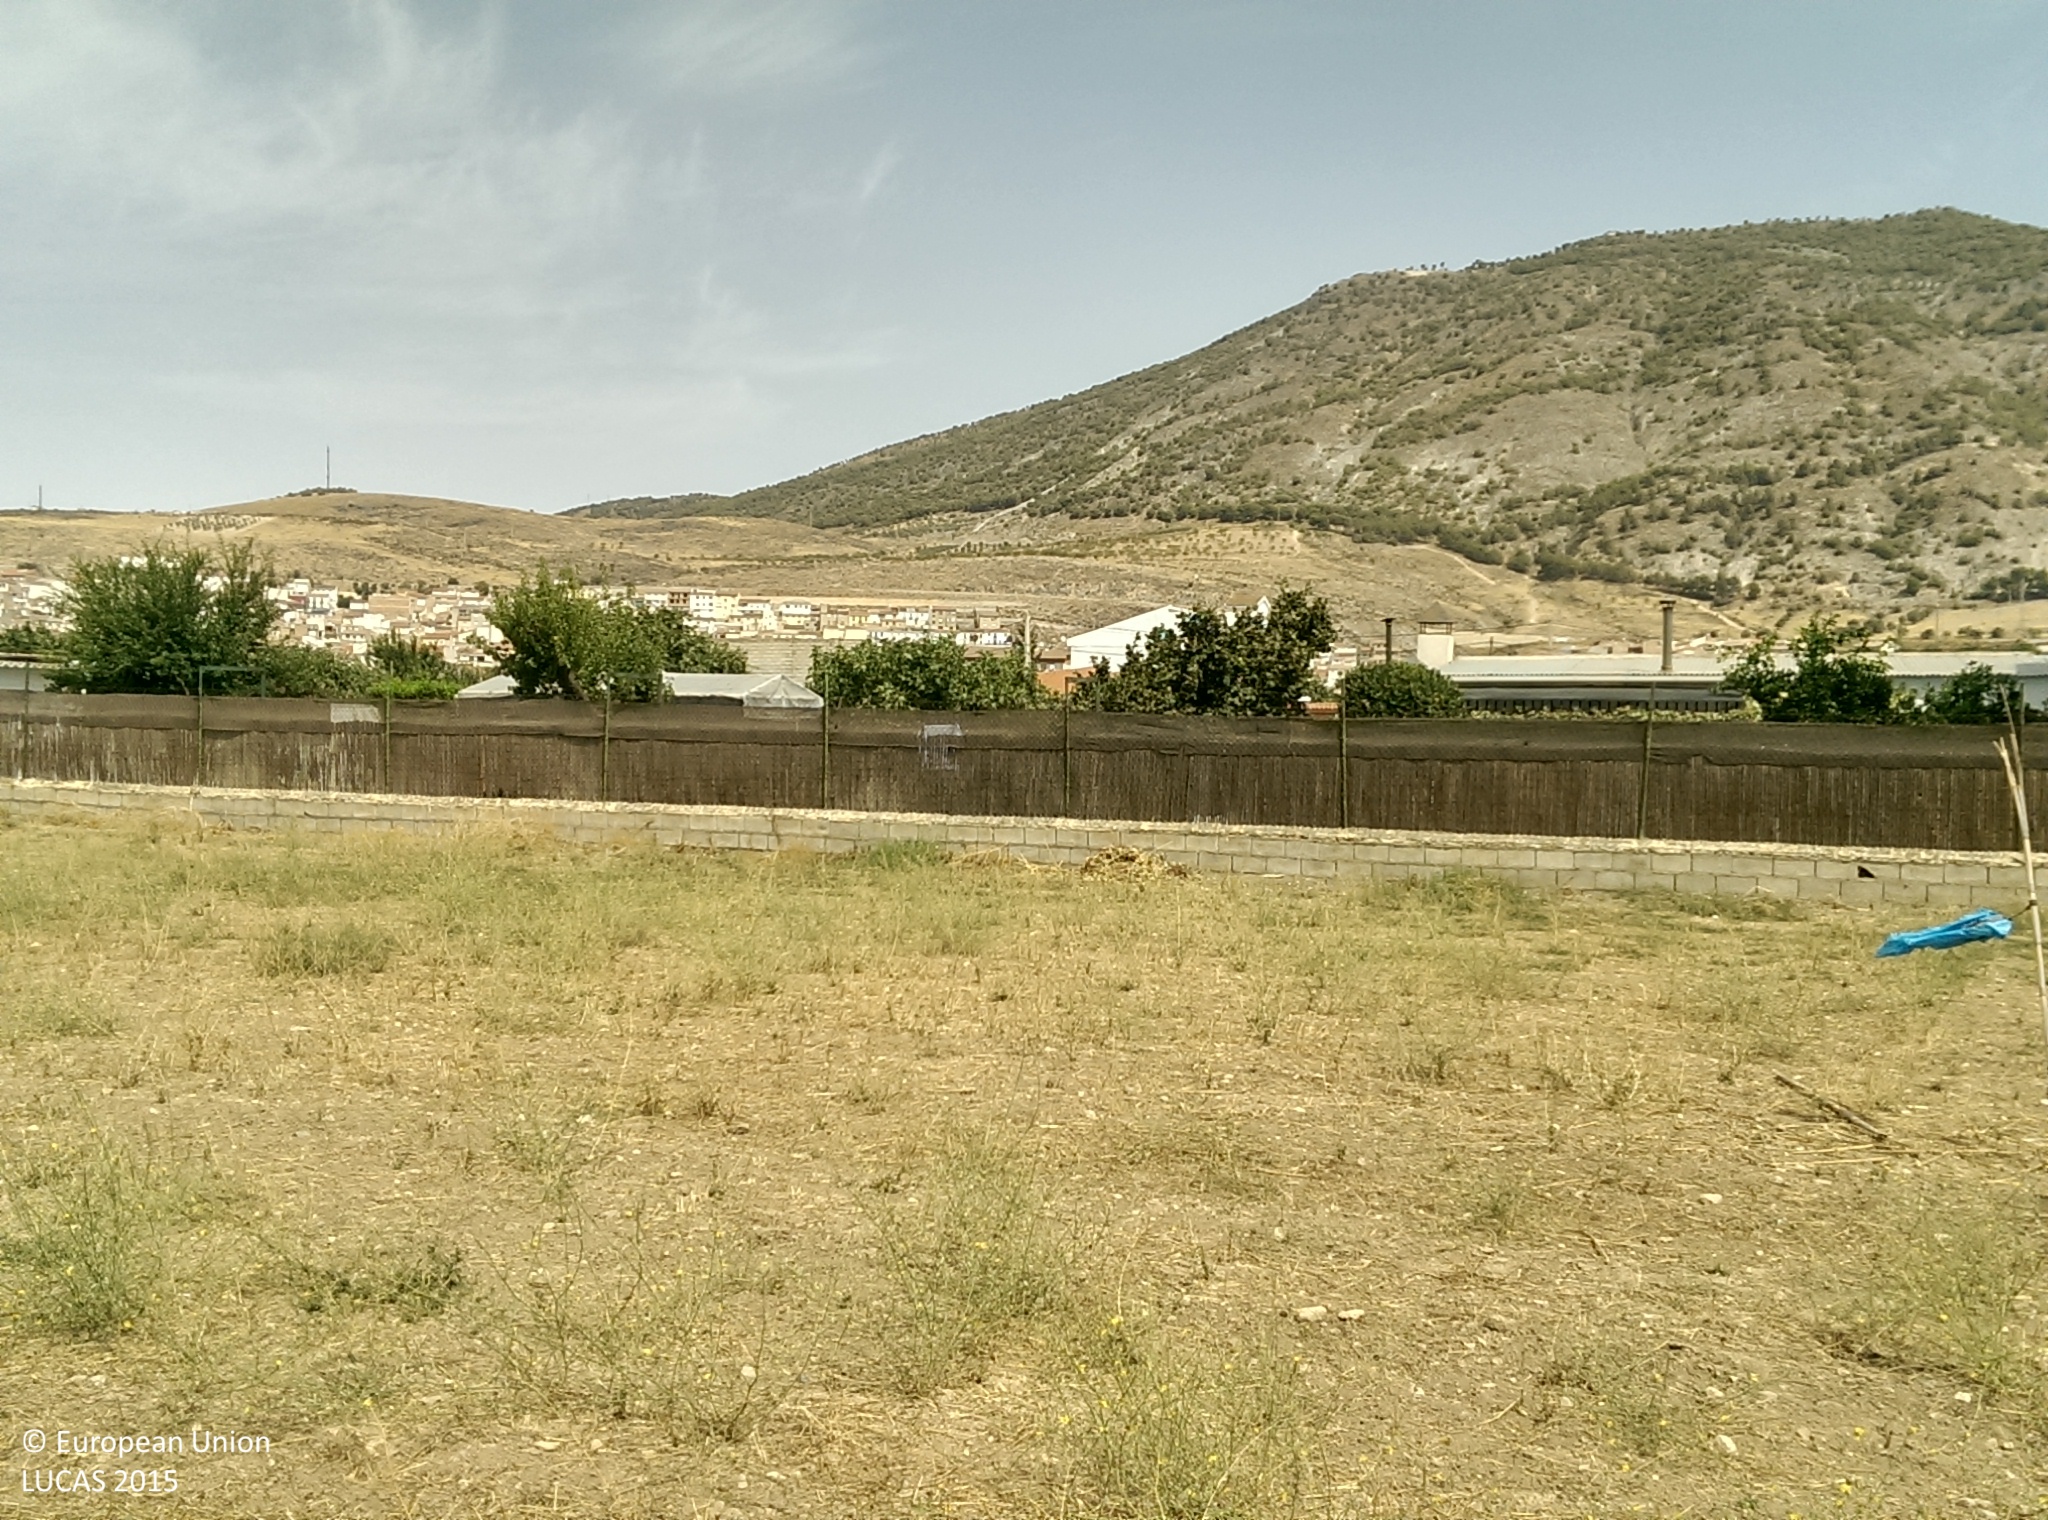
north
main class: Grassland
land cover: Spontaneously vegetated surfaces
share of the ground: 25 - 50 %
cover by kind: unconsolidated bare surface 70 %, herbaceous plants 30 %
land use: Agriculture (excluding fallow land and kitchen gardens)
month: August
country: ES
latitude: 37.0196
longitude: -3.6209
